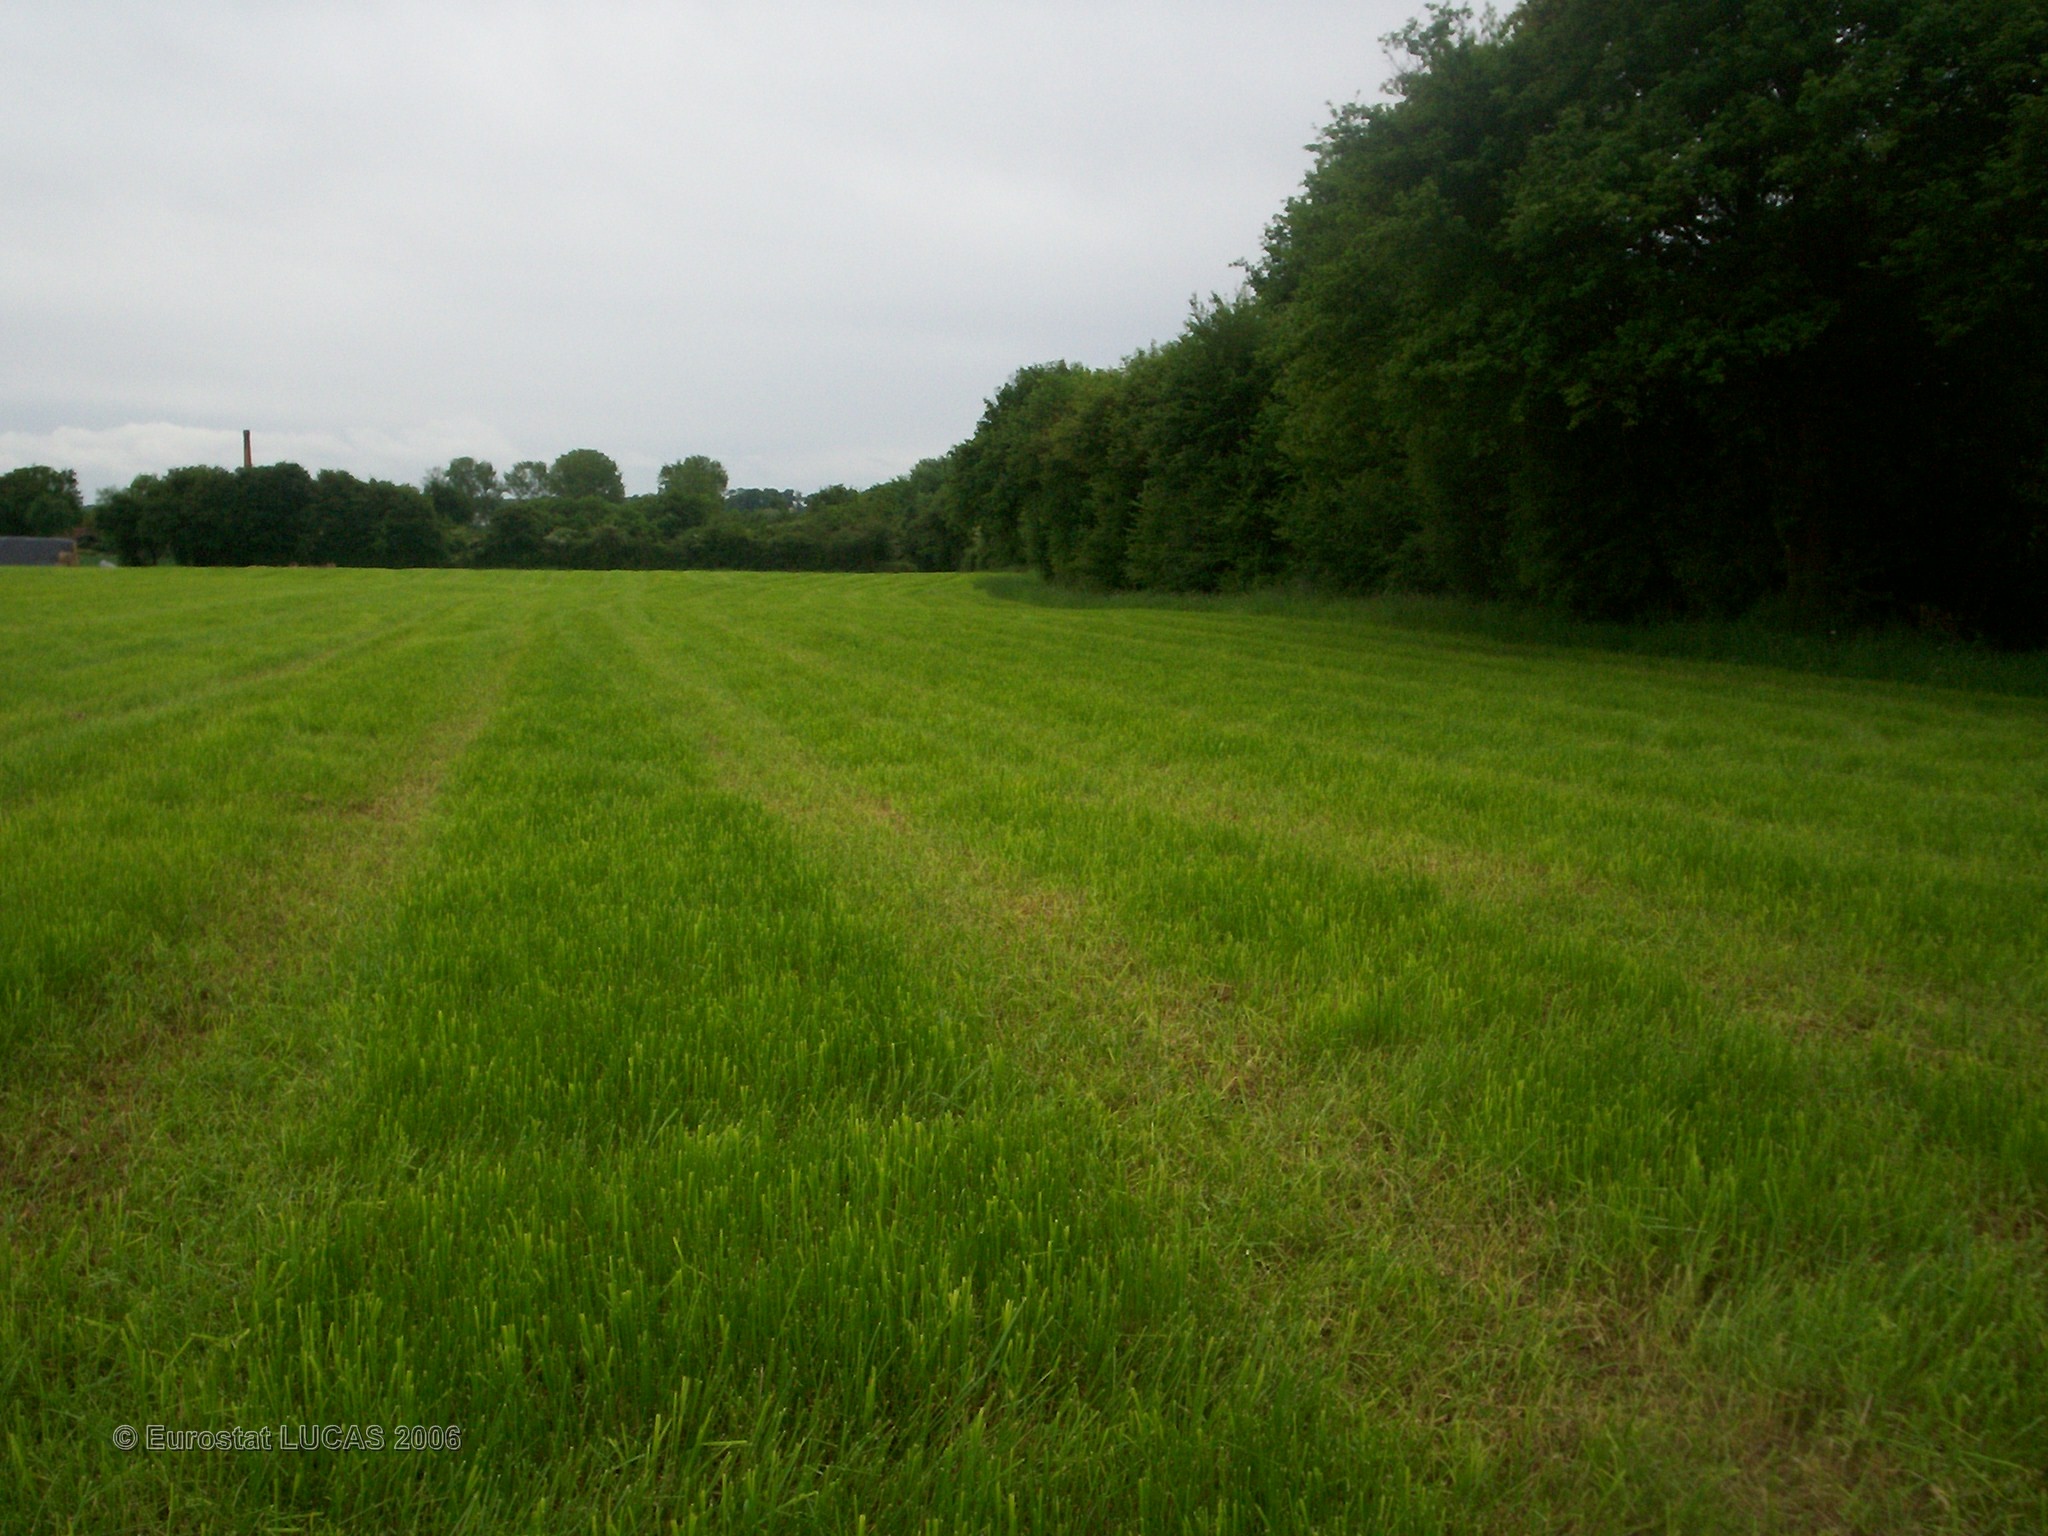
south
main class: Grassland
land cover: Grassland without tree/shrub cover
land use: Agriculture (excluding fallow land and kitchen gardens)
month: May
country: FR
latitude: 47.7961
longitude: 2.9041
